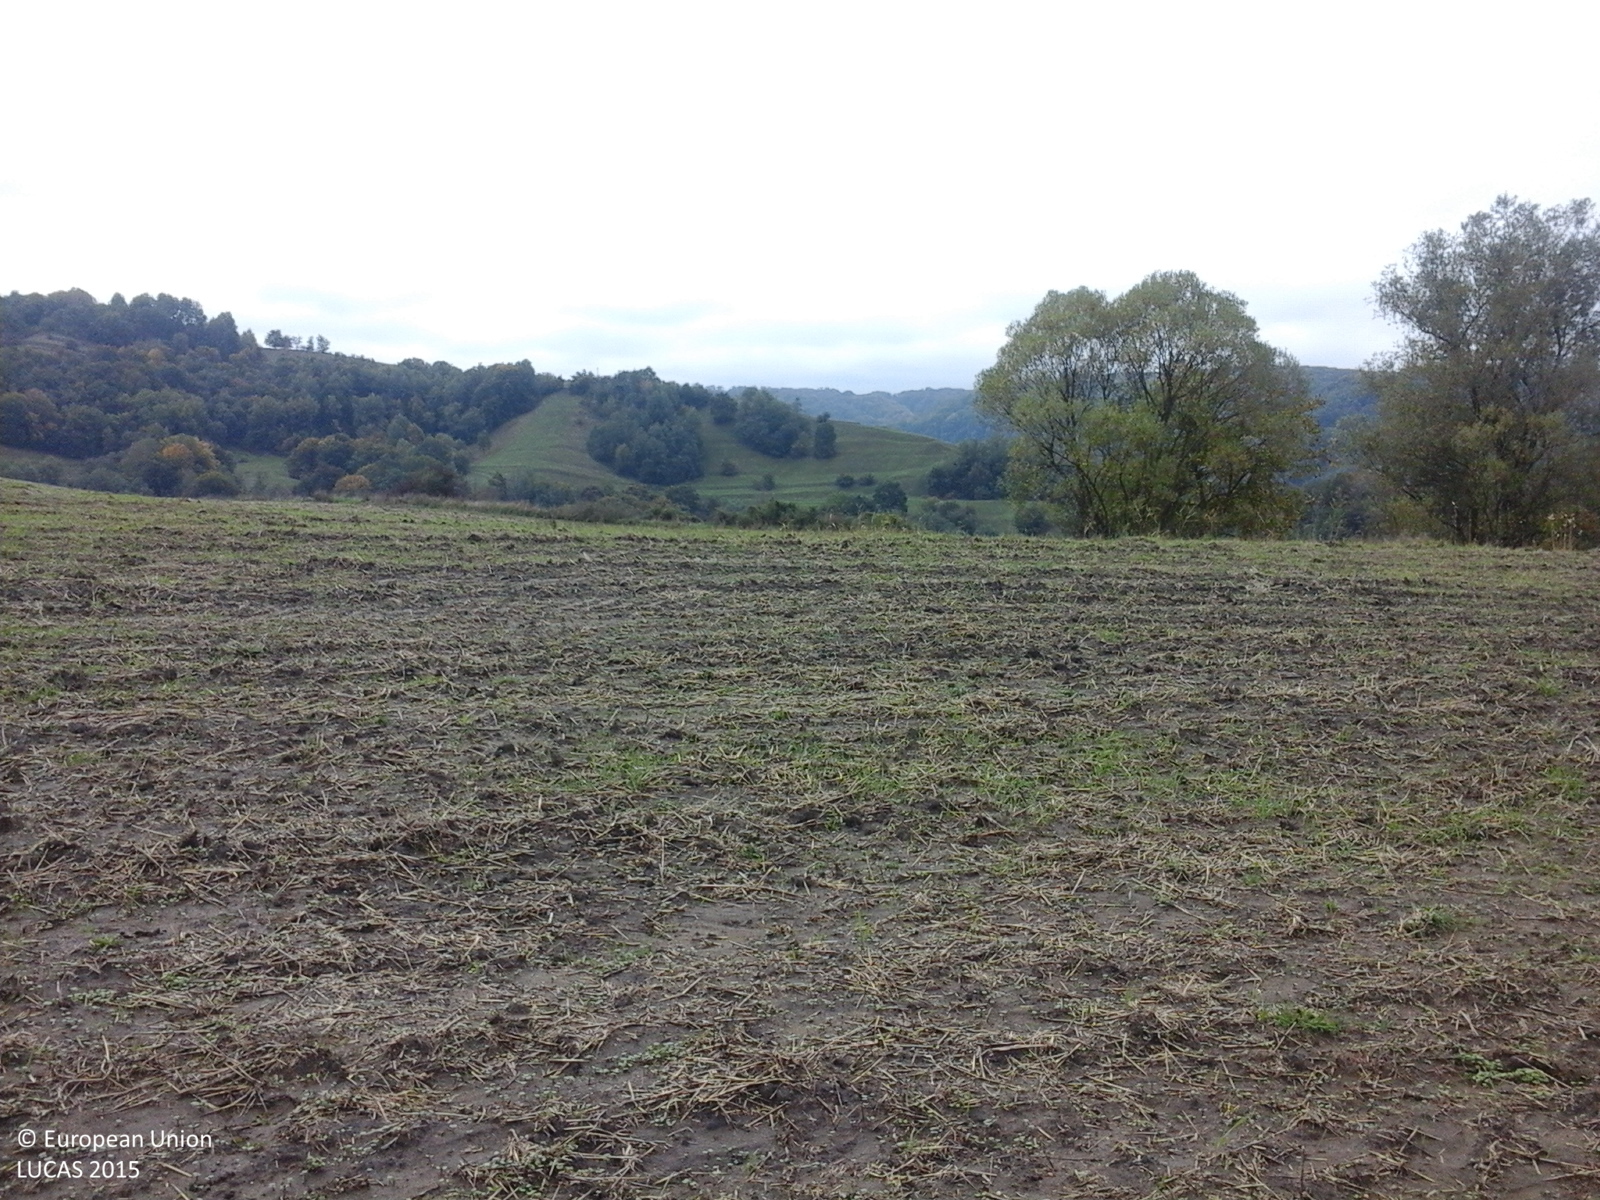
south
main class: Cropland
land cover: Rape and turnip rape
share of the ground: < 10 %
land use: Agriculture (excluding fallow land and kitchen gardens)
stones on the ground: < 10 %
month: October
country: RO
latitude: 46.1013
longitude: 24.2702
